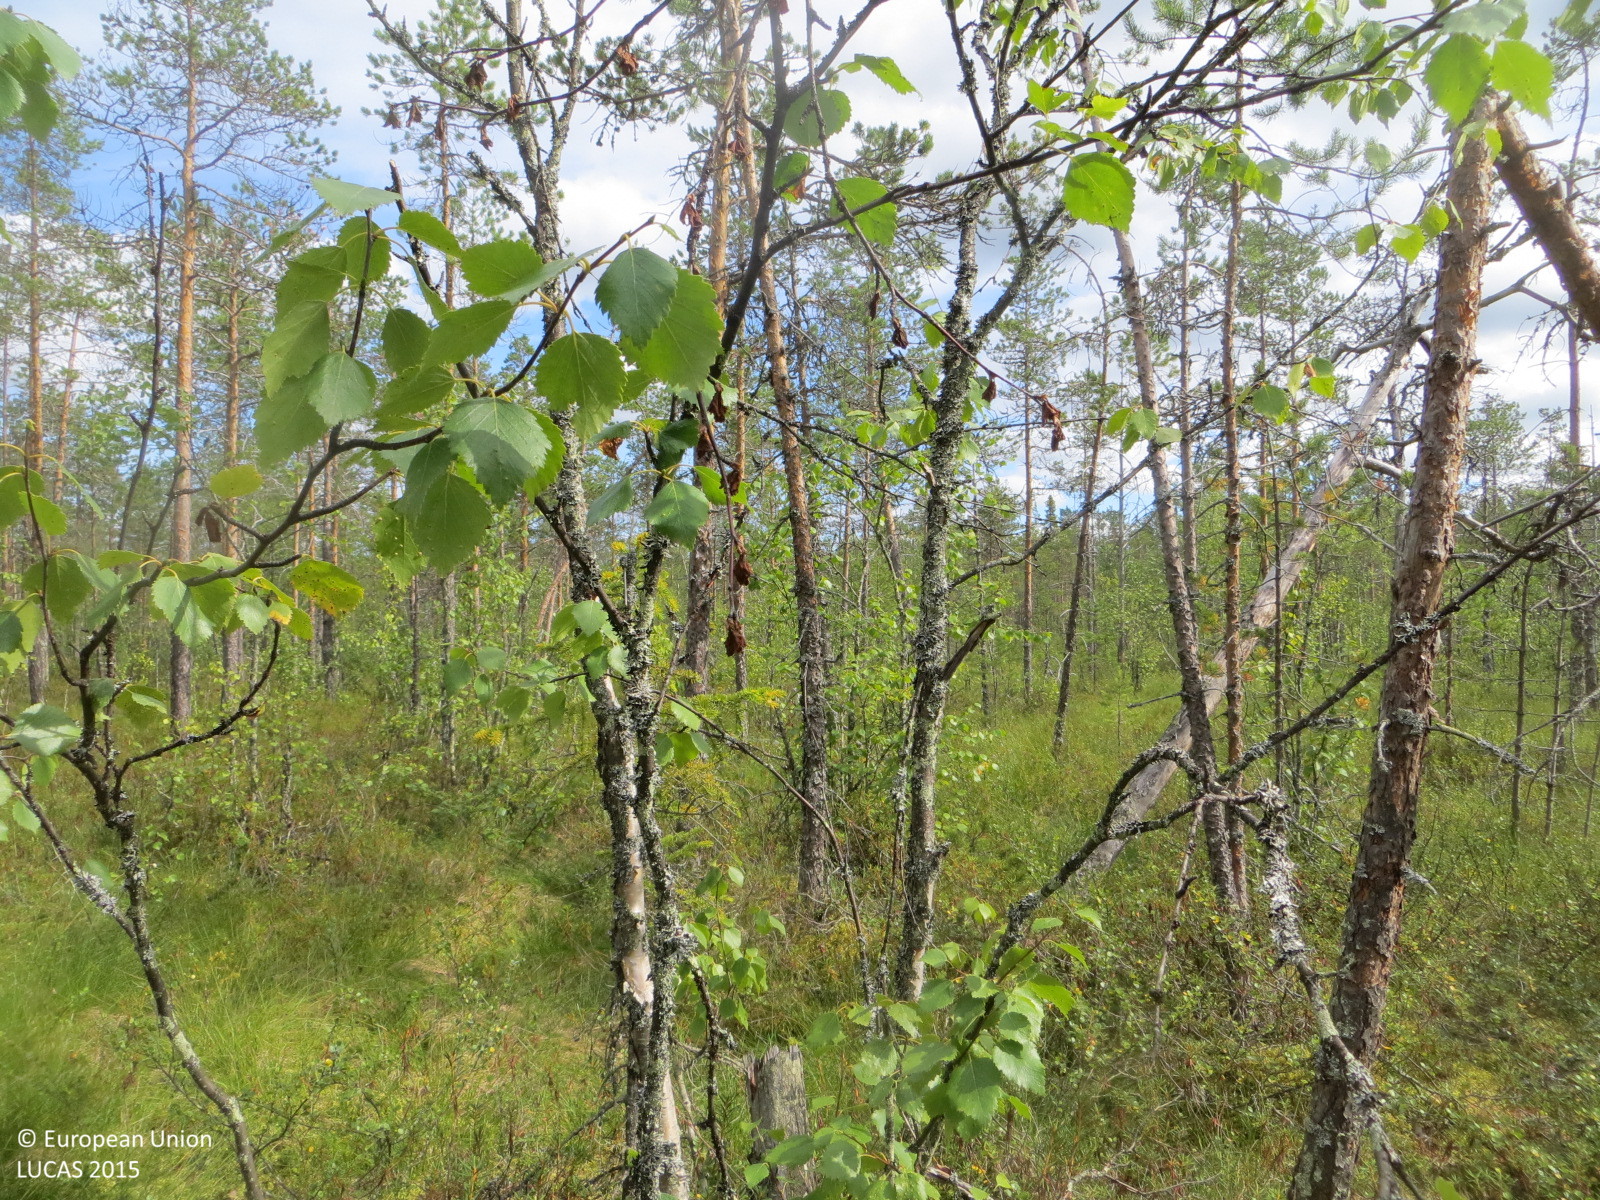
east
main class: Woodland
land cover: Pine dominated coniferous woodland
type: mire and swamp forests
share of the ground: 50 - 75 %
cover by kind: coniferous forest trees 50 %, shrubs 45 %, broadleaved forest trees 5 %
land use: Forestry
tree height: > 5 m
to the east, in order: Pine dominated coniferous woodland; Ditches and canals; Pine dominated coniferous woodland; Other mixed woodland; Ditches and canals; Other mixed woodland
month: August
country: FI
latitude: 66.1886
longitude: 25.4499
